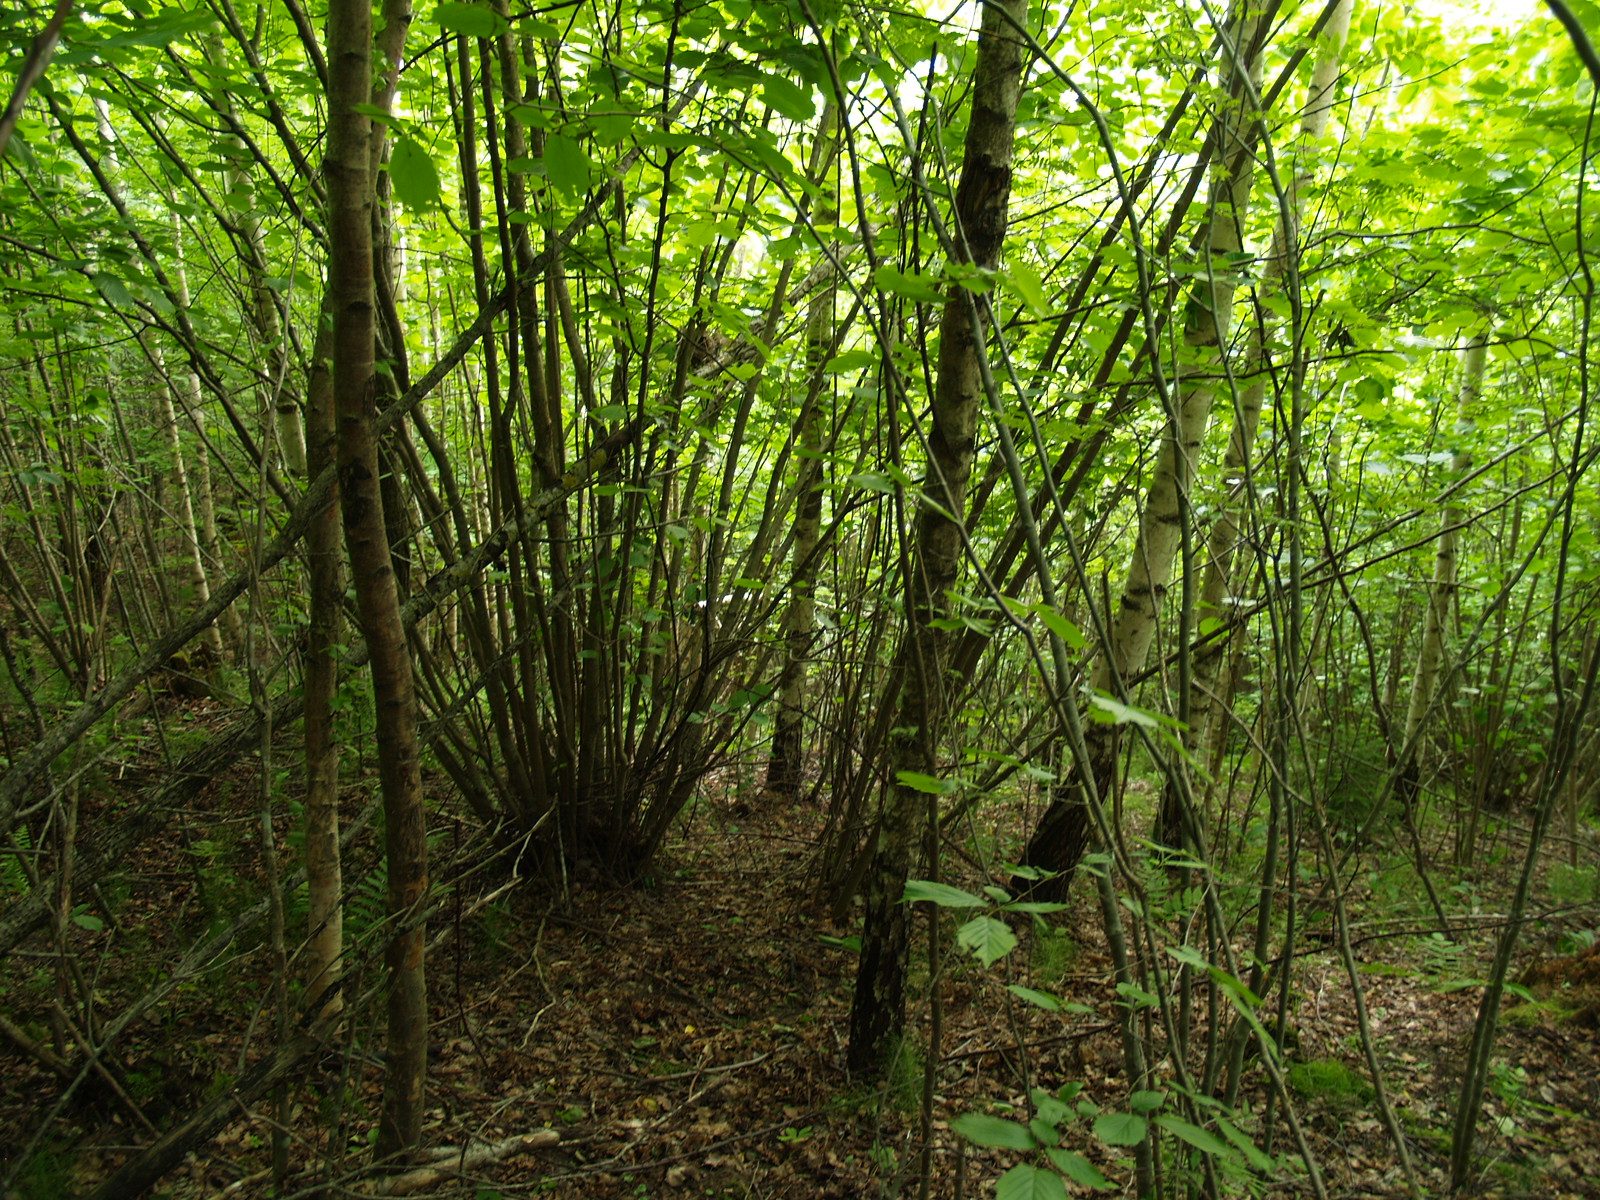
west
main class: Woodland
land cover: Broadleaved woodland
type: non-riverine alder, birch or aspen forest
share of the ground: > 75 %
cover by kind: broadleaved forest trees 100 %
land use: Forestry
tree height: > 5 m
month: June
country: LV
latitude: 56.6275
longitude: 25.6911
